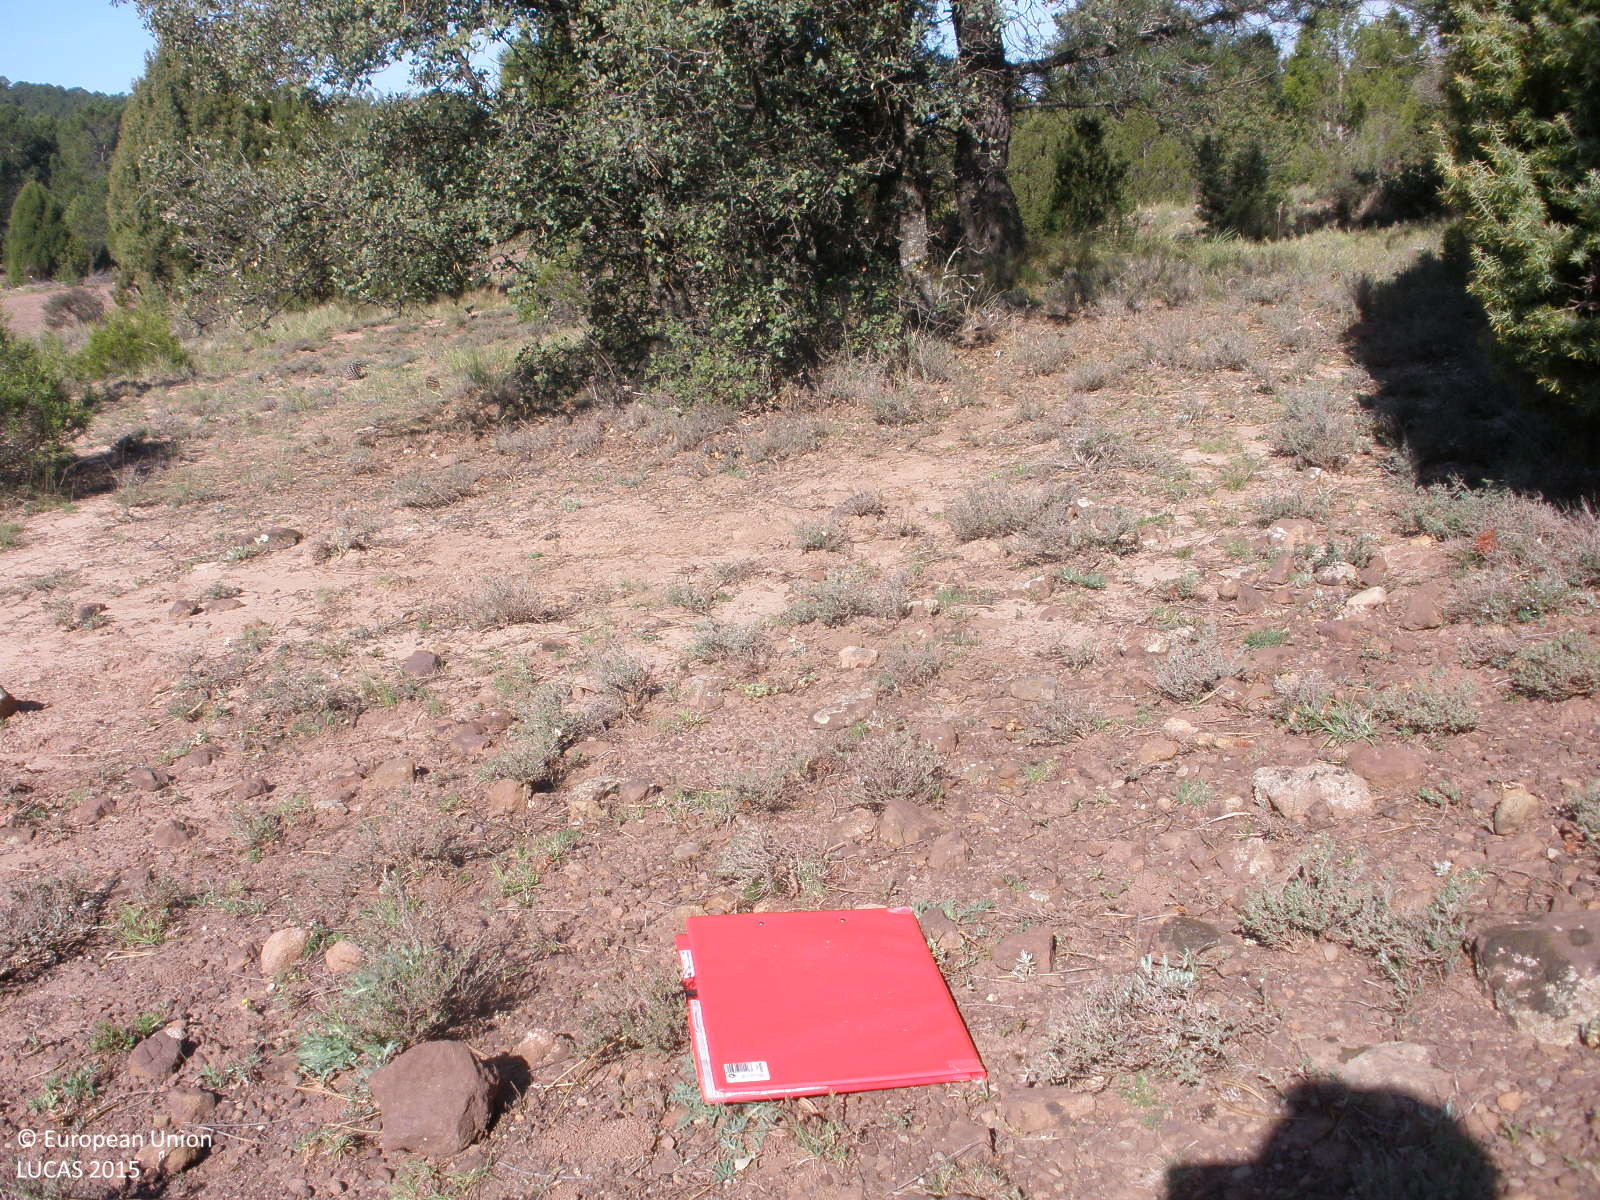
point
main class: Woodland
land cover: Other mixed woodland
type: coniferous forest of the mediterranean region
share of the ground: 50 - 75 %
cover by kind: consolidated bare surface 40 %, coniferous forest trees 30 %, broadleaved forest trees 20 %, shrubs 10 %
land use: Semi-natural and natural areas not in use
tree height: < 5 m
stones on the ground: 25 - 50 %
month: April
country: ES
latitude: 40.2951
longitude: -0.7484
